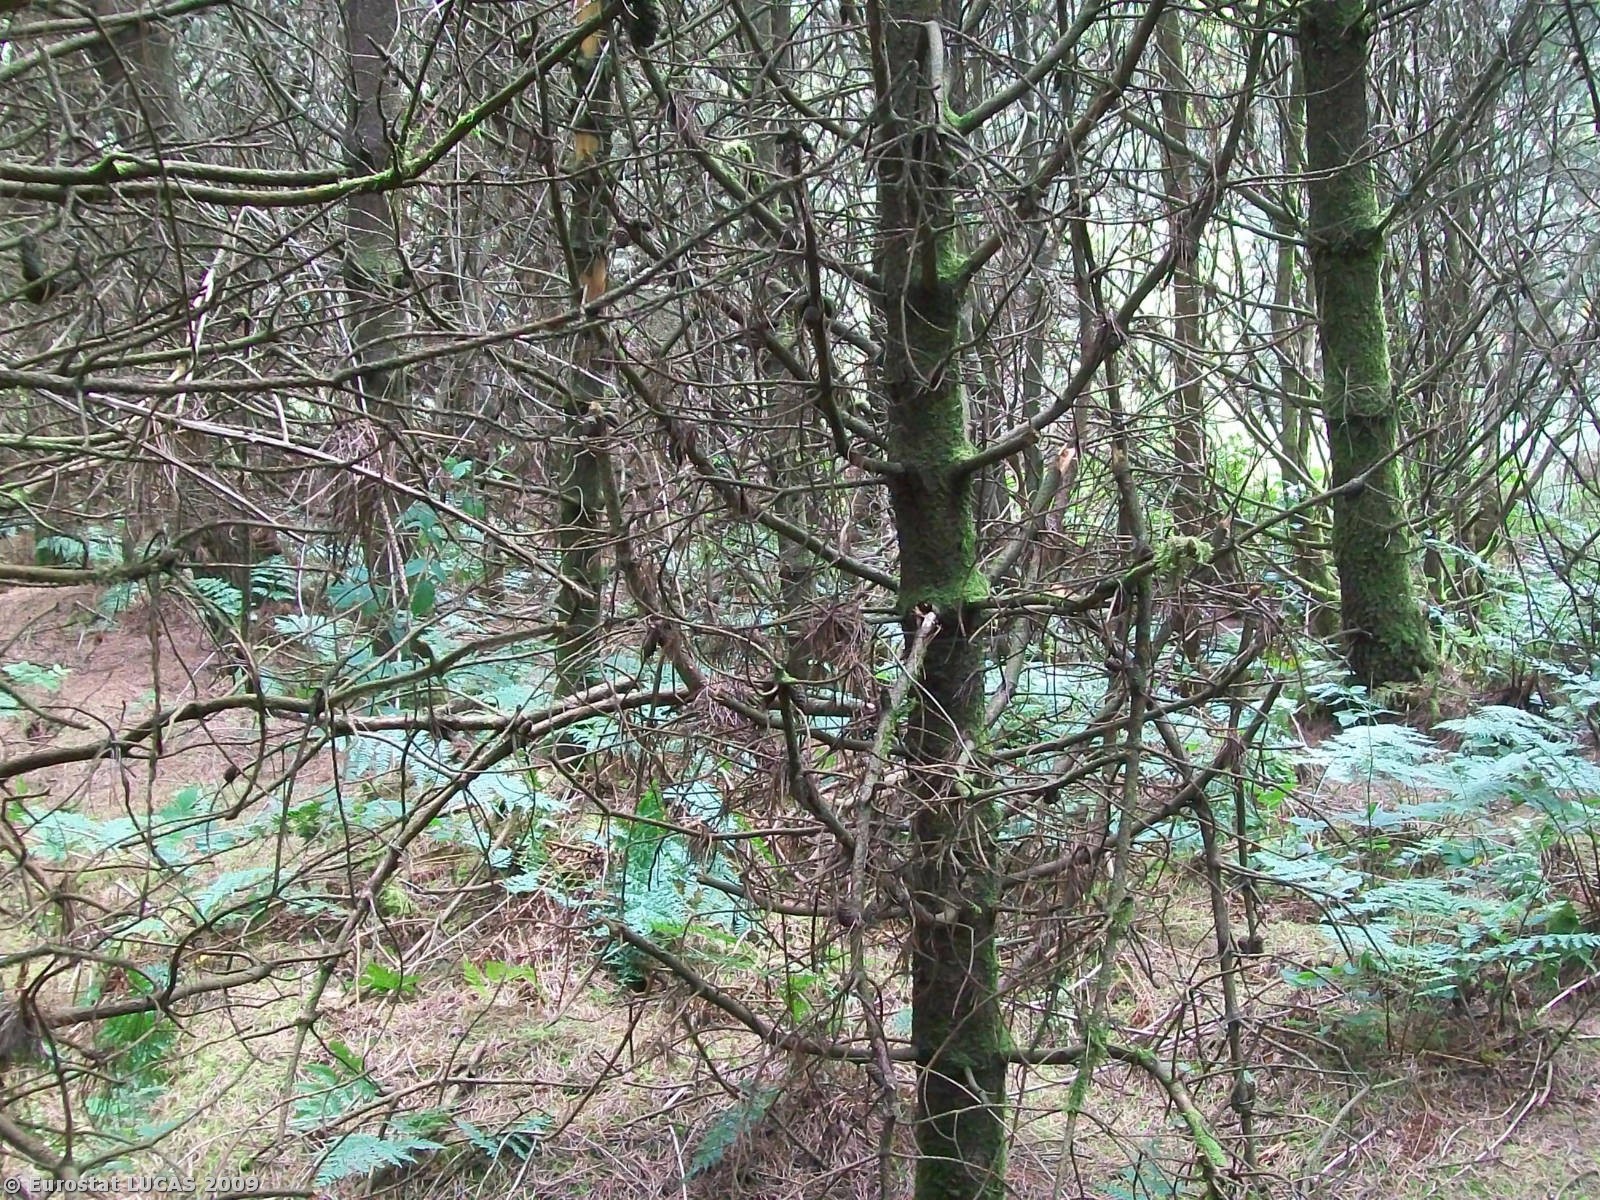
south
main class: Woodland
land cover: Coniferous woodland
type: plantations and self-sown exotic forest
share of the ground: > 75 %
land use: Forestry
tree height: > 5 m
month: July
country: GB
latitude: 55.2061
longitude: -6.3173
